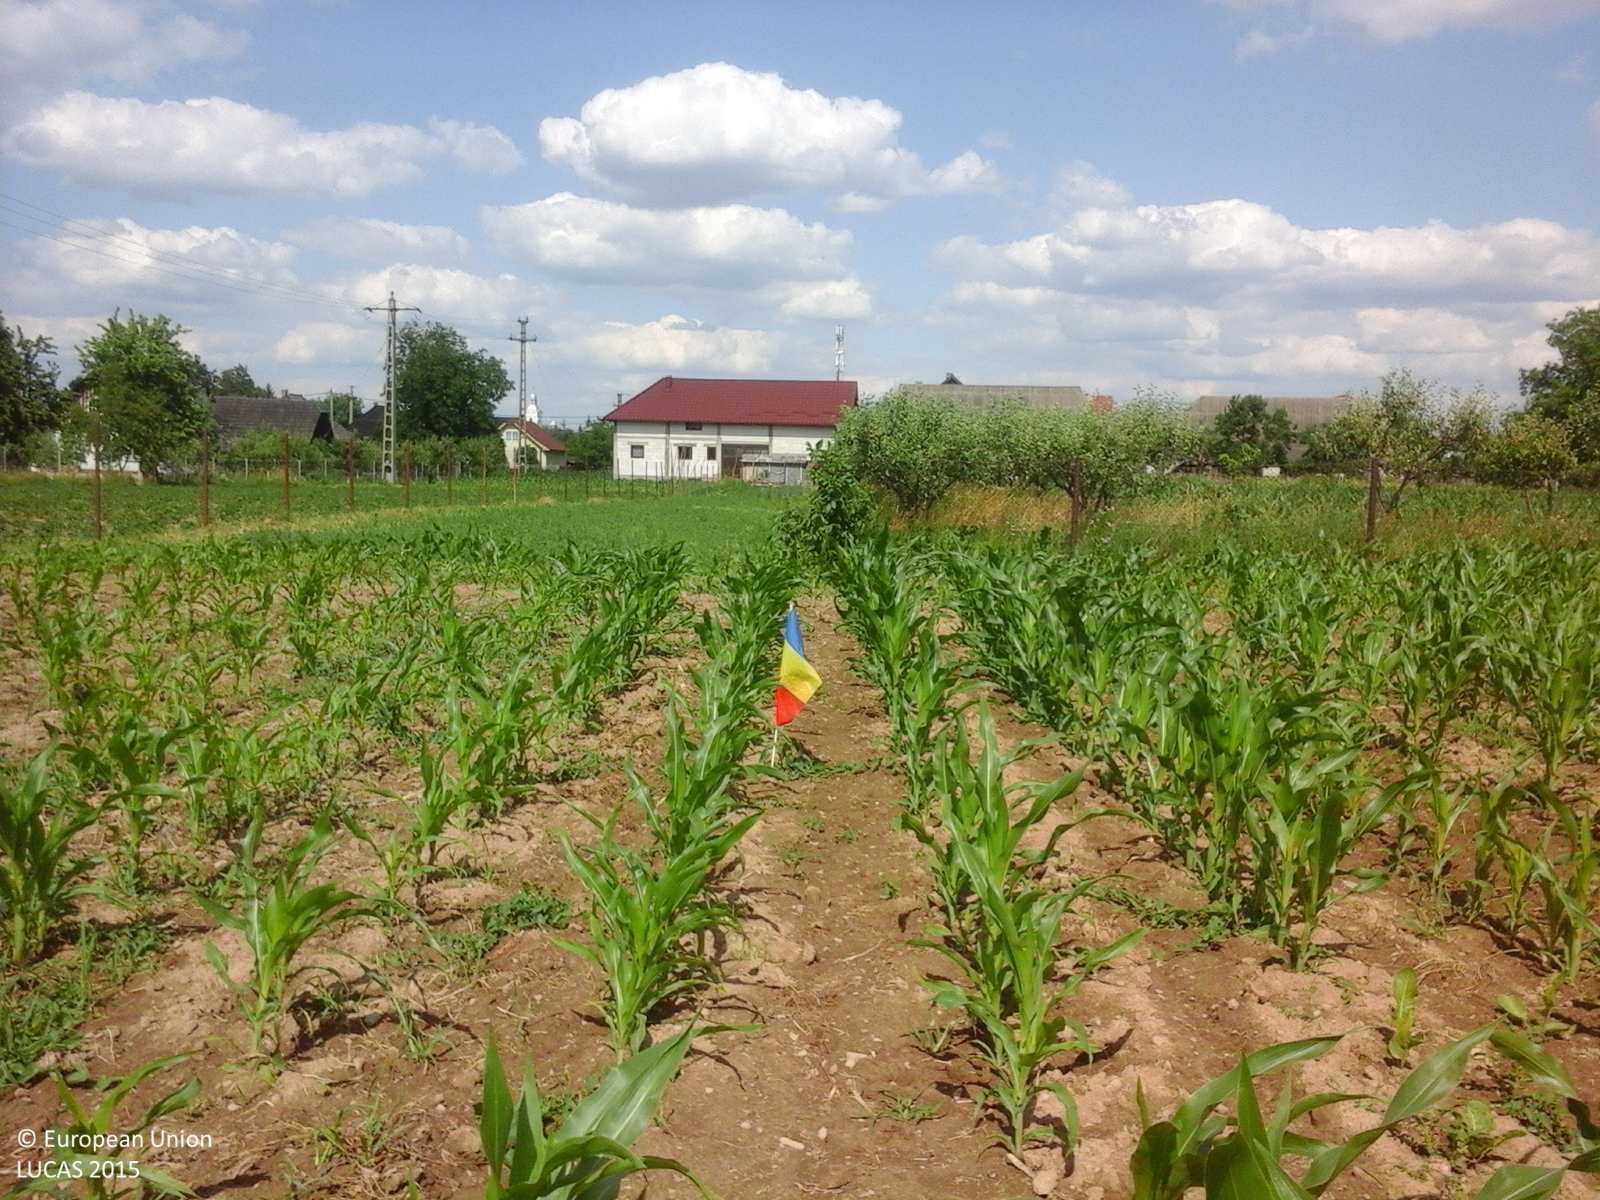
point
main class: Cropland
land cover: Maize
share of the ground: 25 - 50 %
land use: Agriculture (excluding fallow land and kitchen gardens)
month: June
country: RO
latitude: 47.8057
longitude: 25.8154
